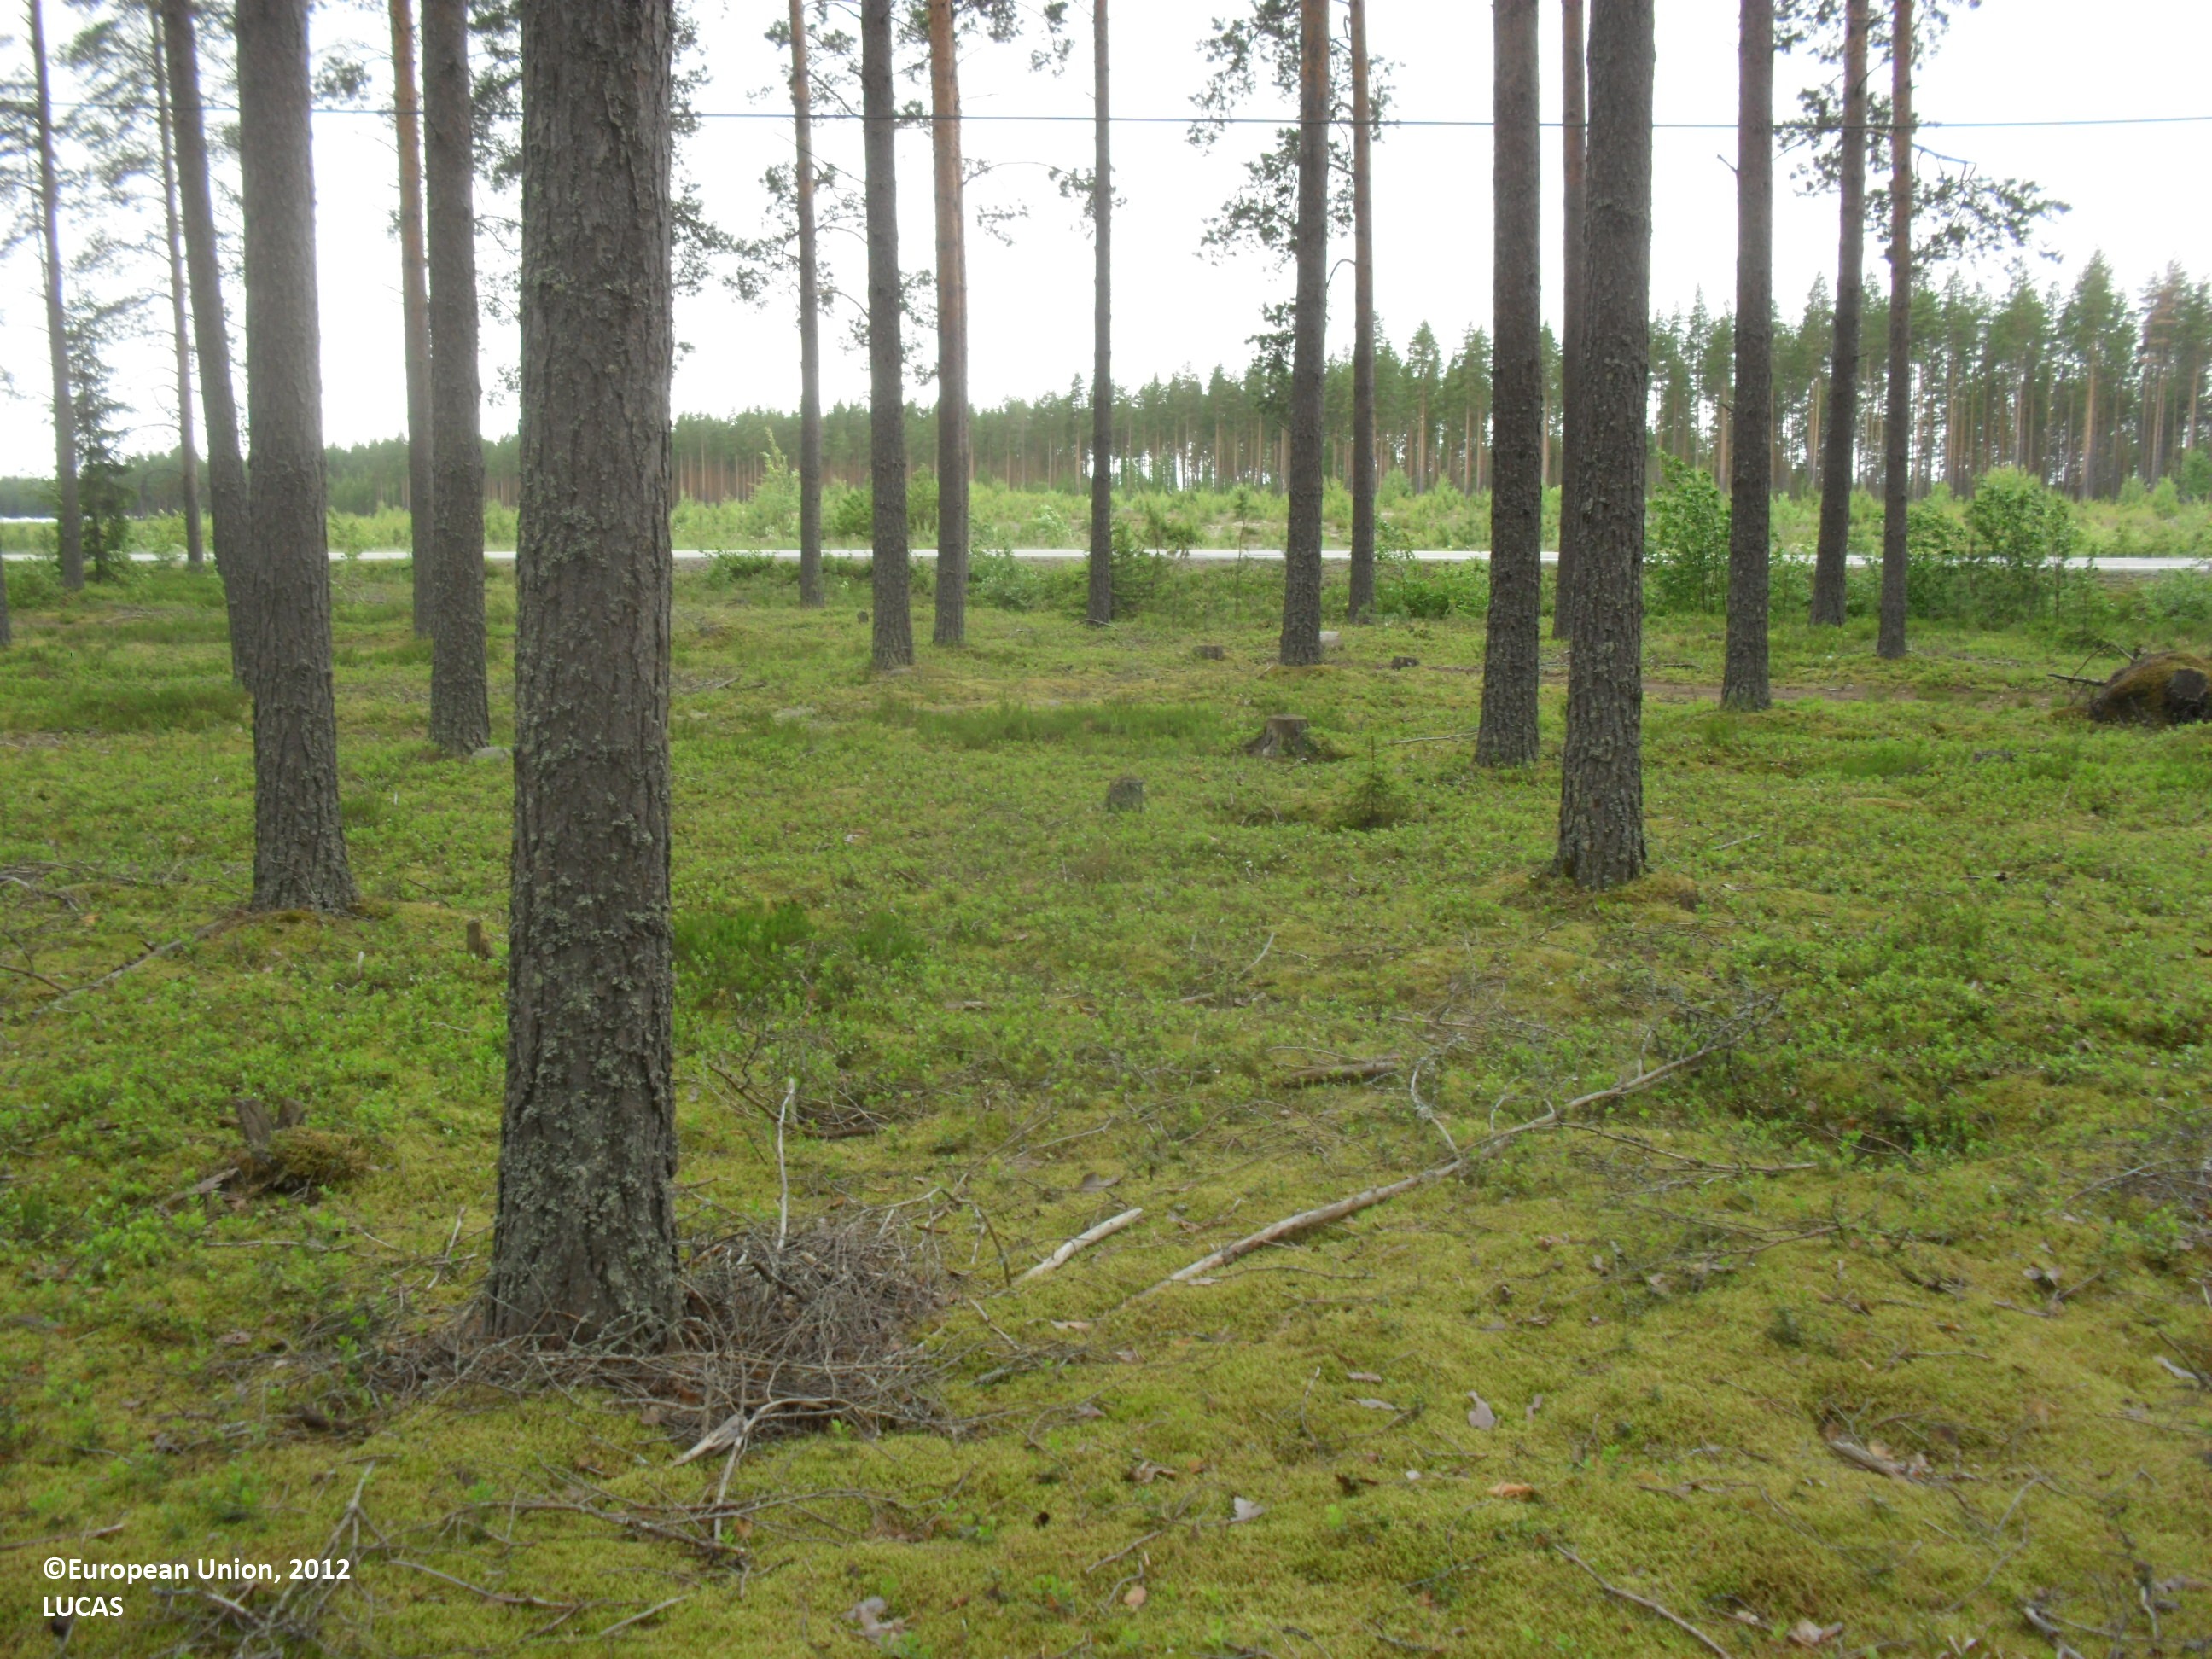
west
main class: Woodland
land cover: Pine dominated coniferous woodland
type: boreal forest
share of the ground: 25 - 50 %
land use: Forestry
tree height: > 5 m
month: June
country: FI
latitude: 62.9521
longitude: 23.5305
